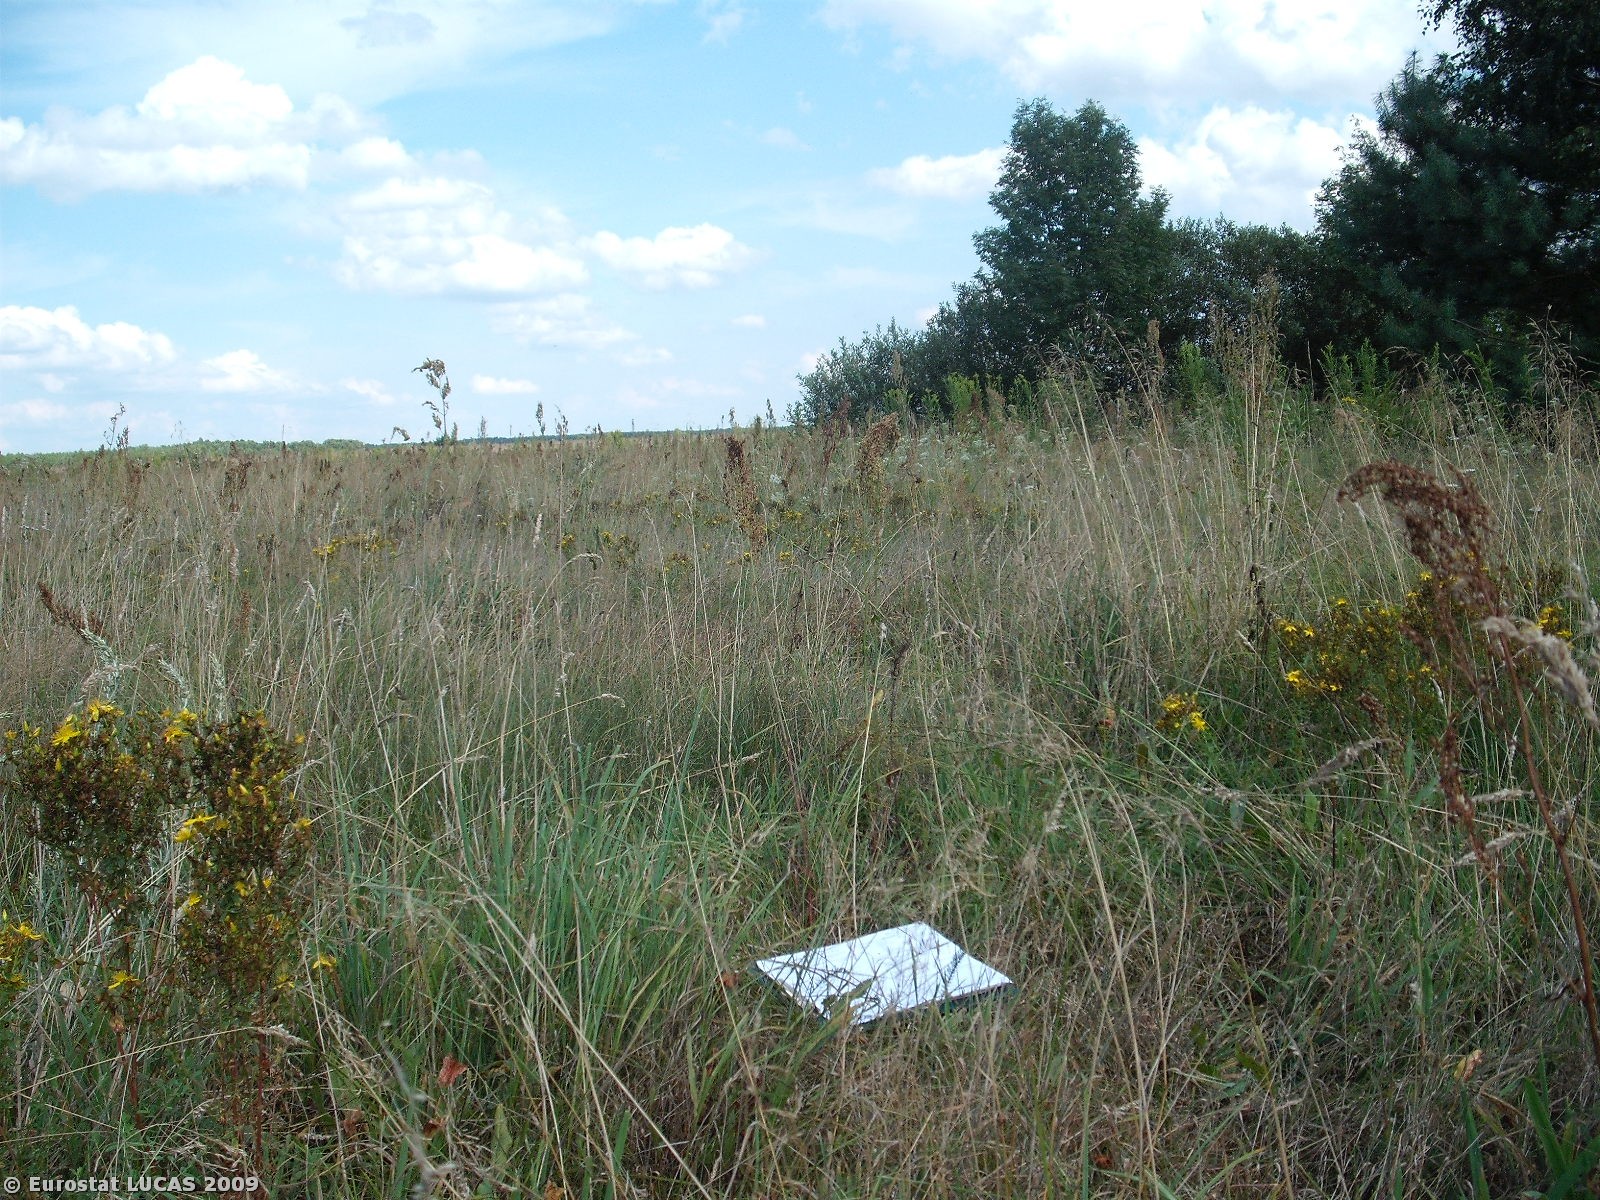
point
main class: Grassland
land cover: Grassland without tree/shrub cover
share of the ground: > 75 %
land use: Agriculture (excluding fallow land and kitchen gardens)
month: August
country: PL
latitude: 51.8054
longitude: 21.6115
